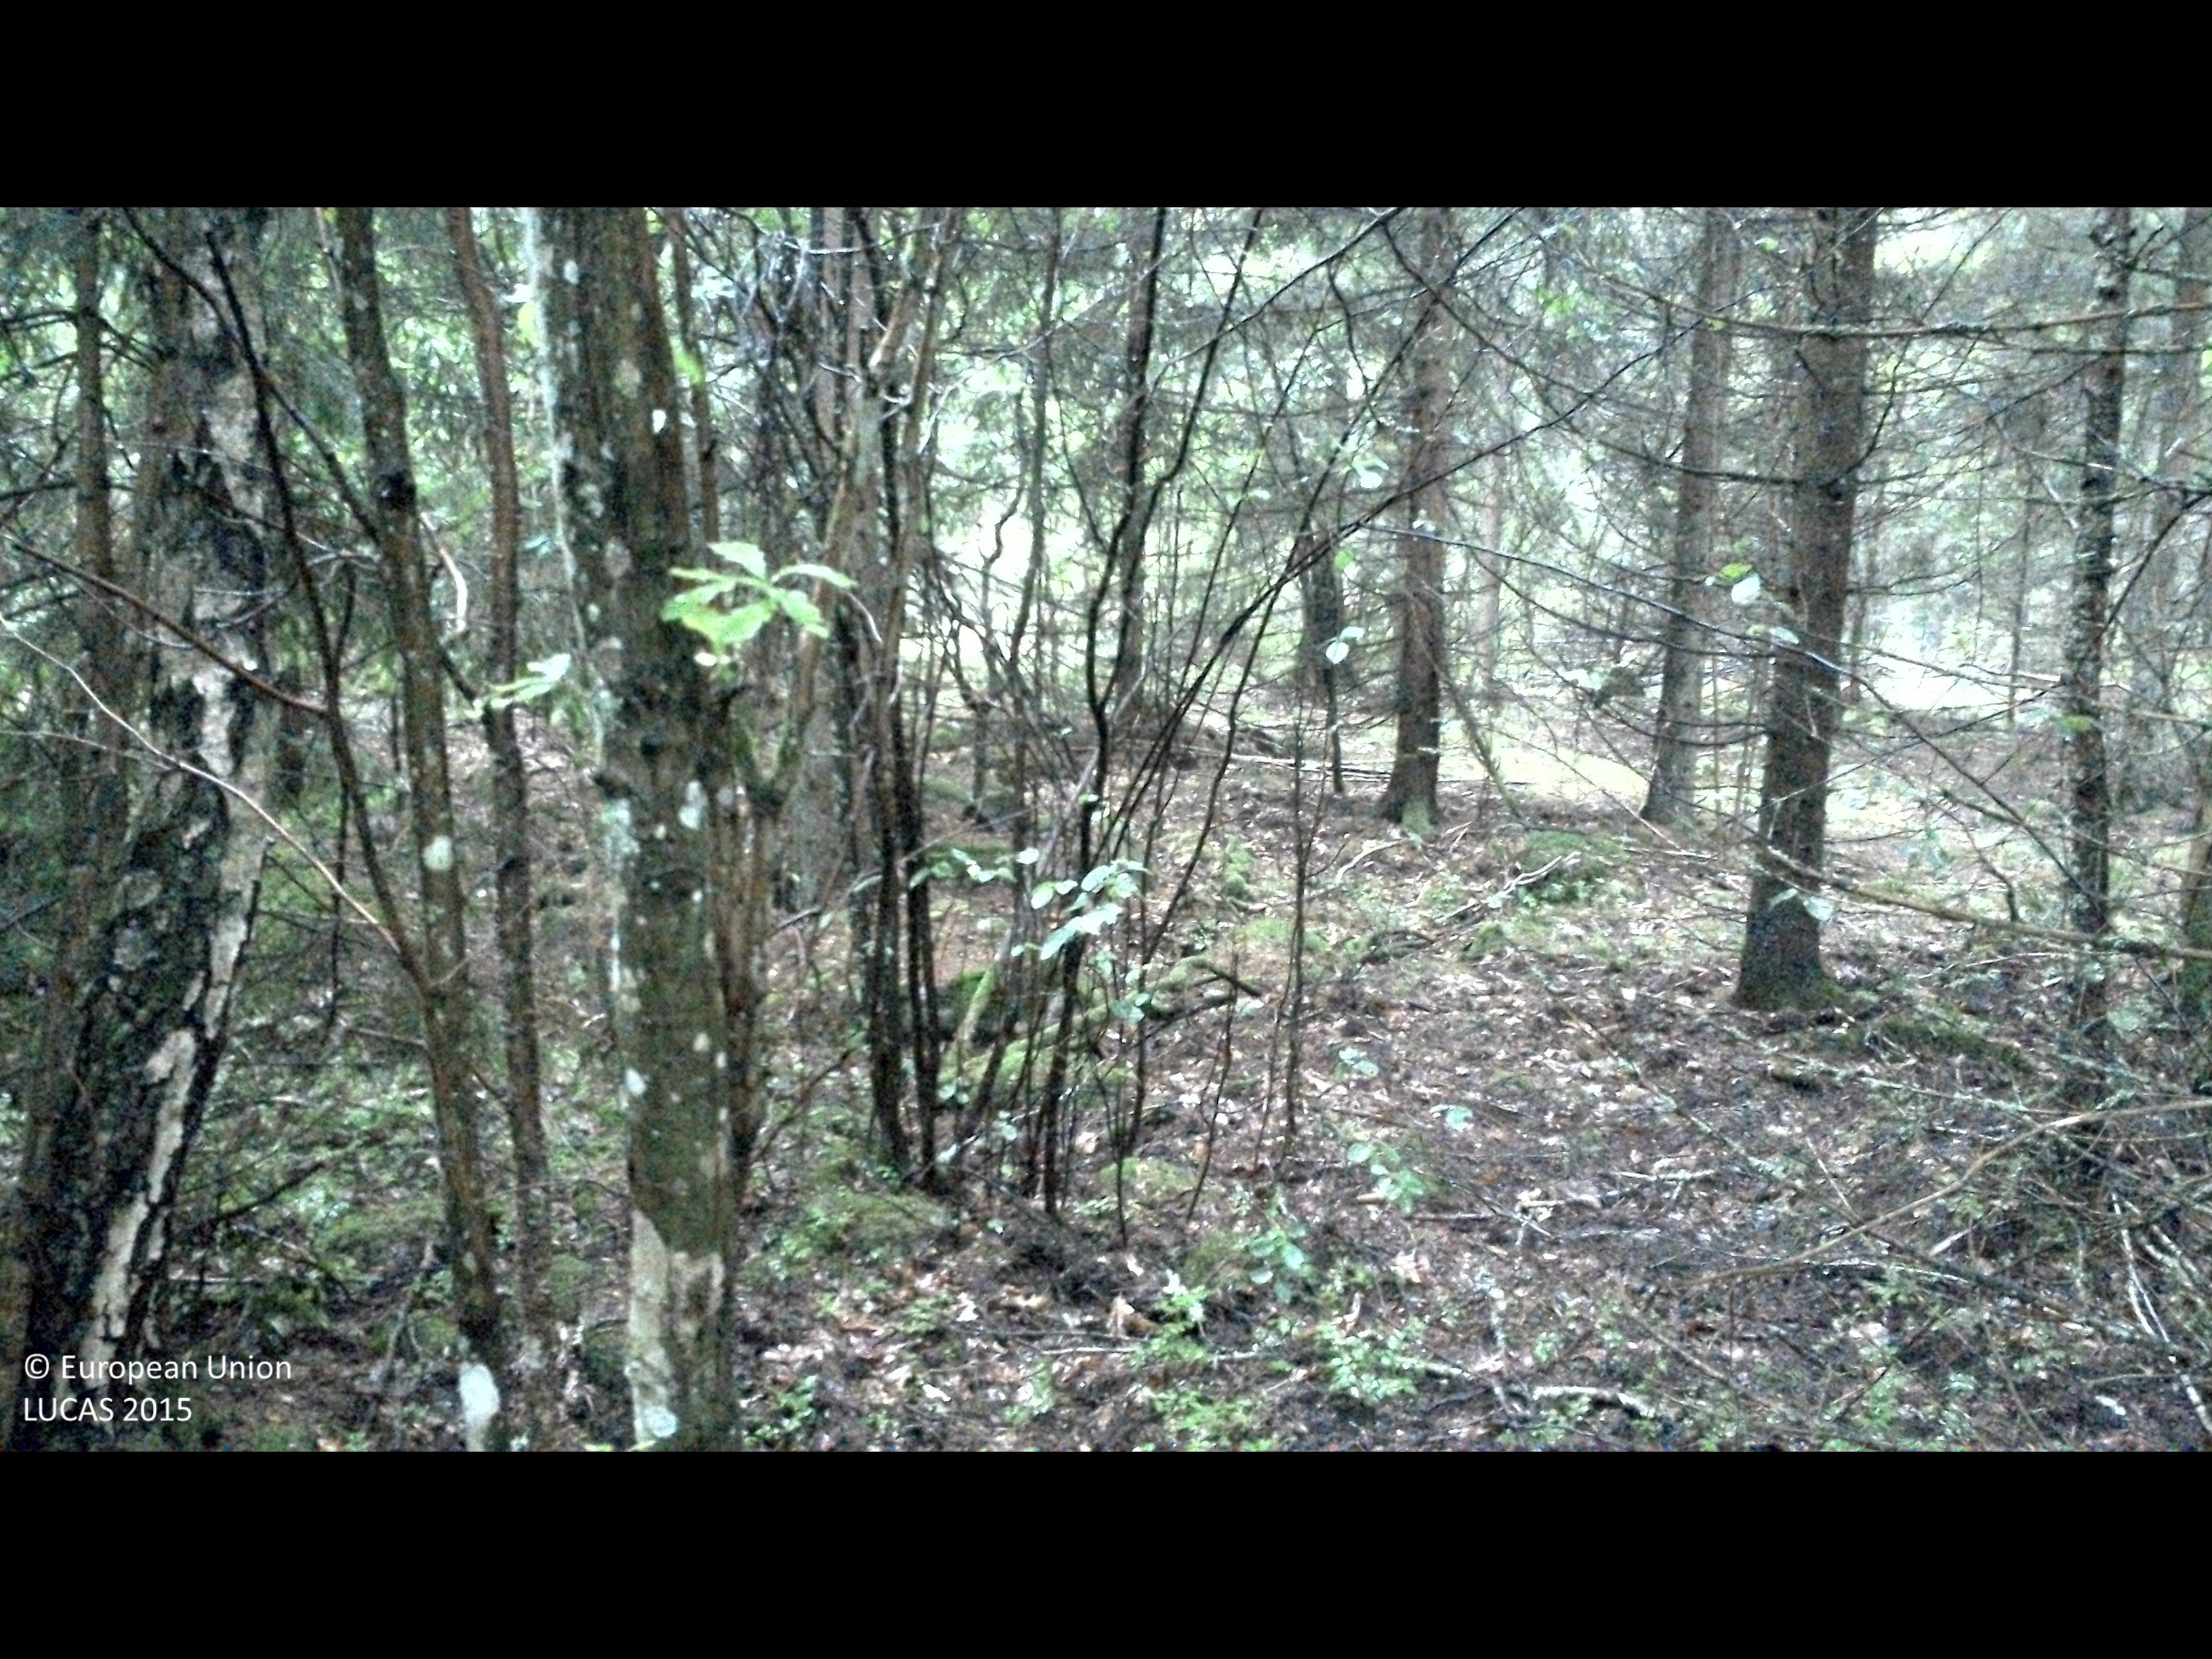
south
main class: Woodland
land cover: Spruce dominated mixed woodland
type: boreal forest
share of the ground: > 75 %
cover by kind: coniferous forest trees 50 %, broadleaved forest trees 25 %, shrubs 10 %, lichens and mosses 10 %, herbaceous plants 5 %
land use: Forestry
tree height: > 5 m
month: June
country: SE
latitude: 56.4120
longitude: 15.9160
